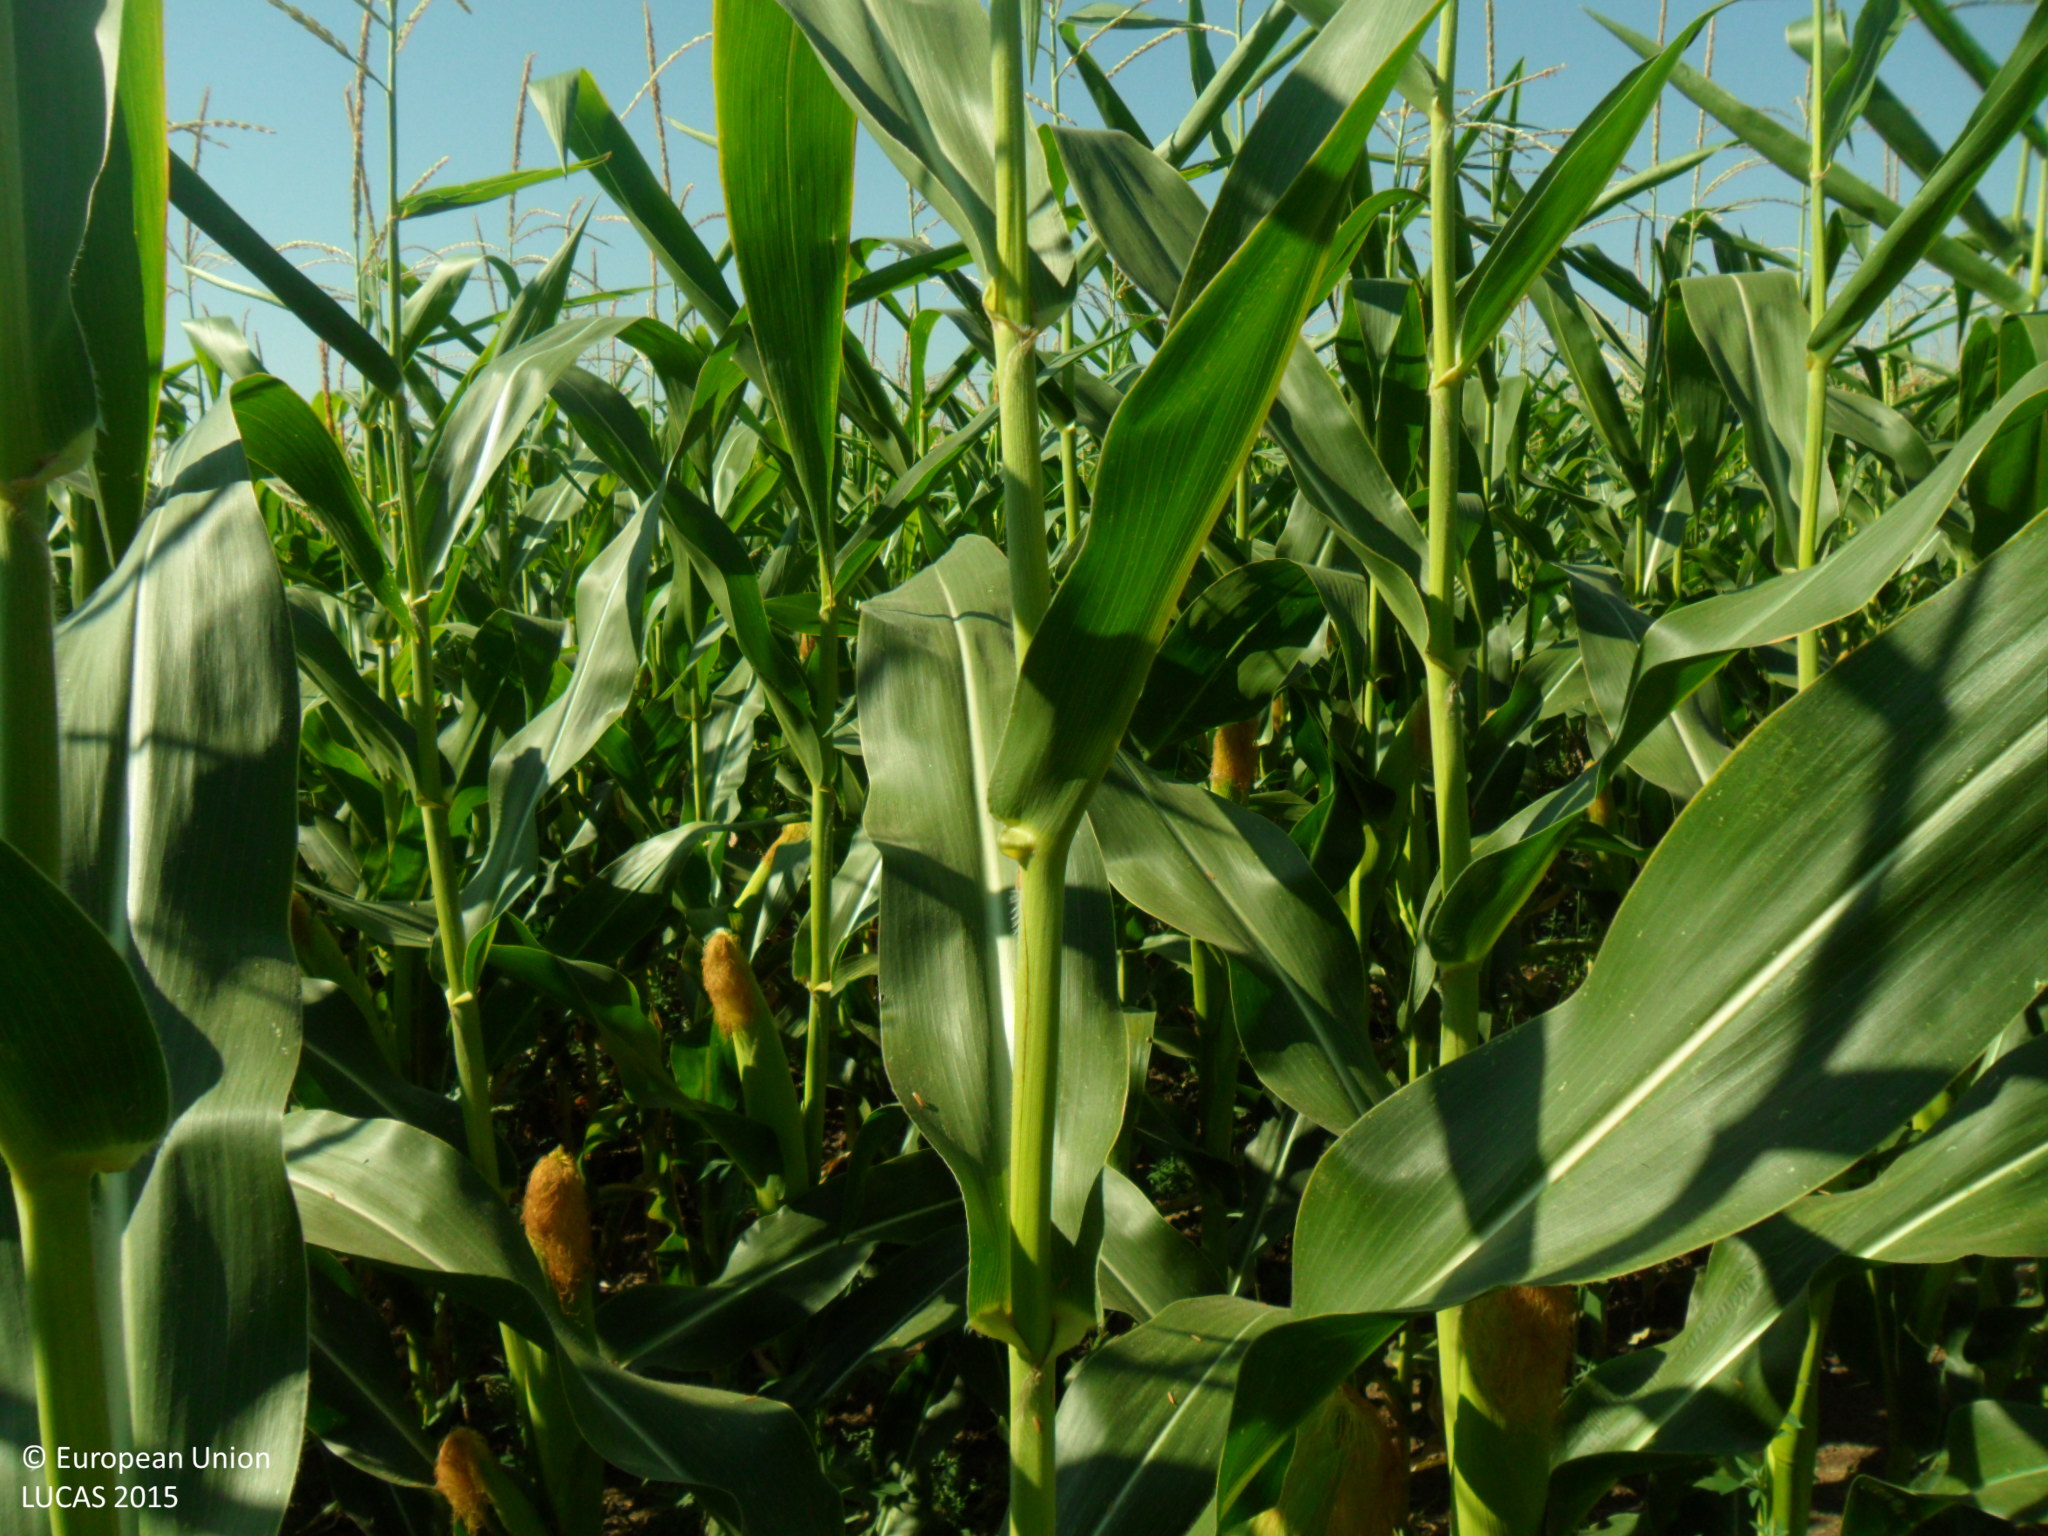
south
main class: Cropland
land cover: Maize
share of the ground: > 75 %
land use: Agriculture (excluding fallow land and kitchen gardens)
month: July
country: BG
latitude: 43.8084
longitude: 26.2753
